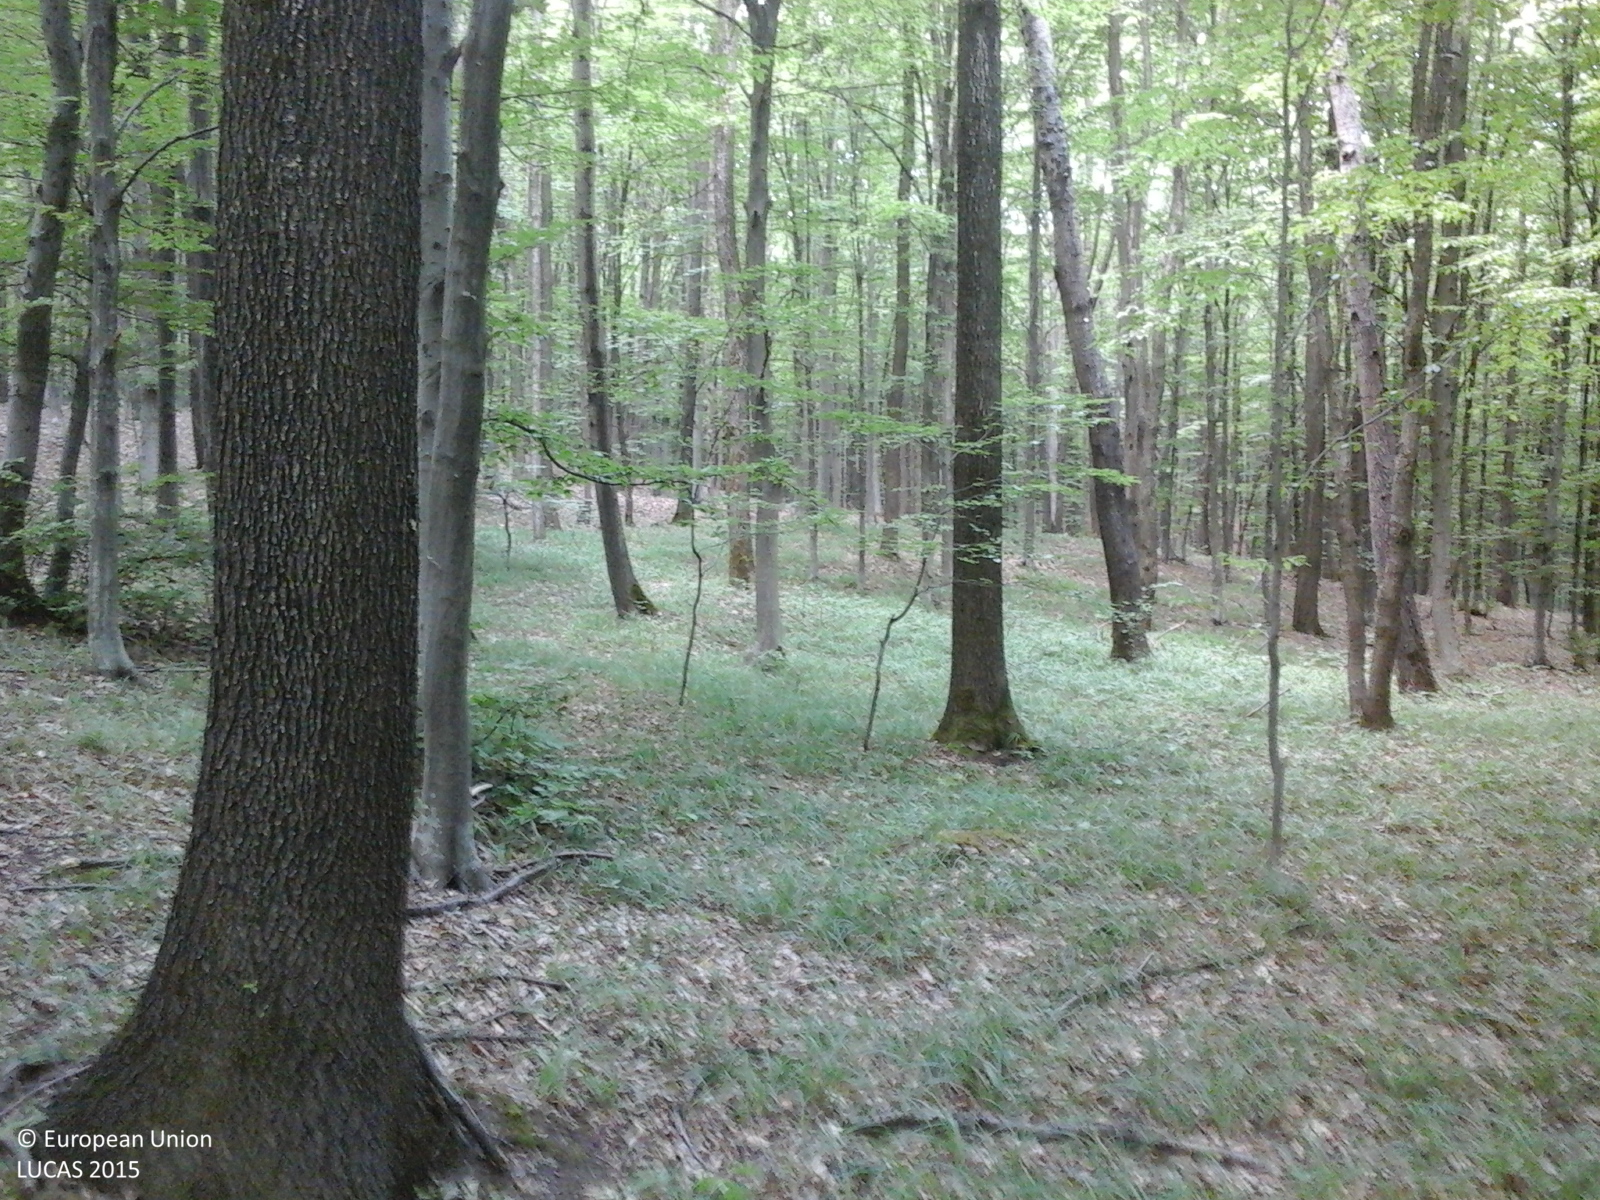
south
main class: Woodland
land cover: Broadleaved woodland
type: beech forest
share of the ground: > 75 %
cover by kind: broadleaved forest trees 95 %, herbaceous plants 5 %
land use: Forestry
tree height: > 5 m
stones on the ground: < 10 %
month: June
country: RO
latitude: 47.8543
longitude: 26.3524
